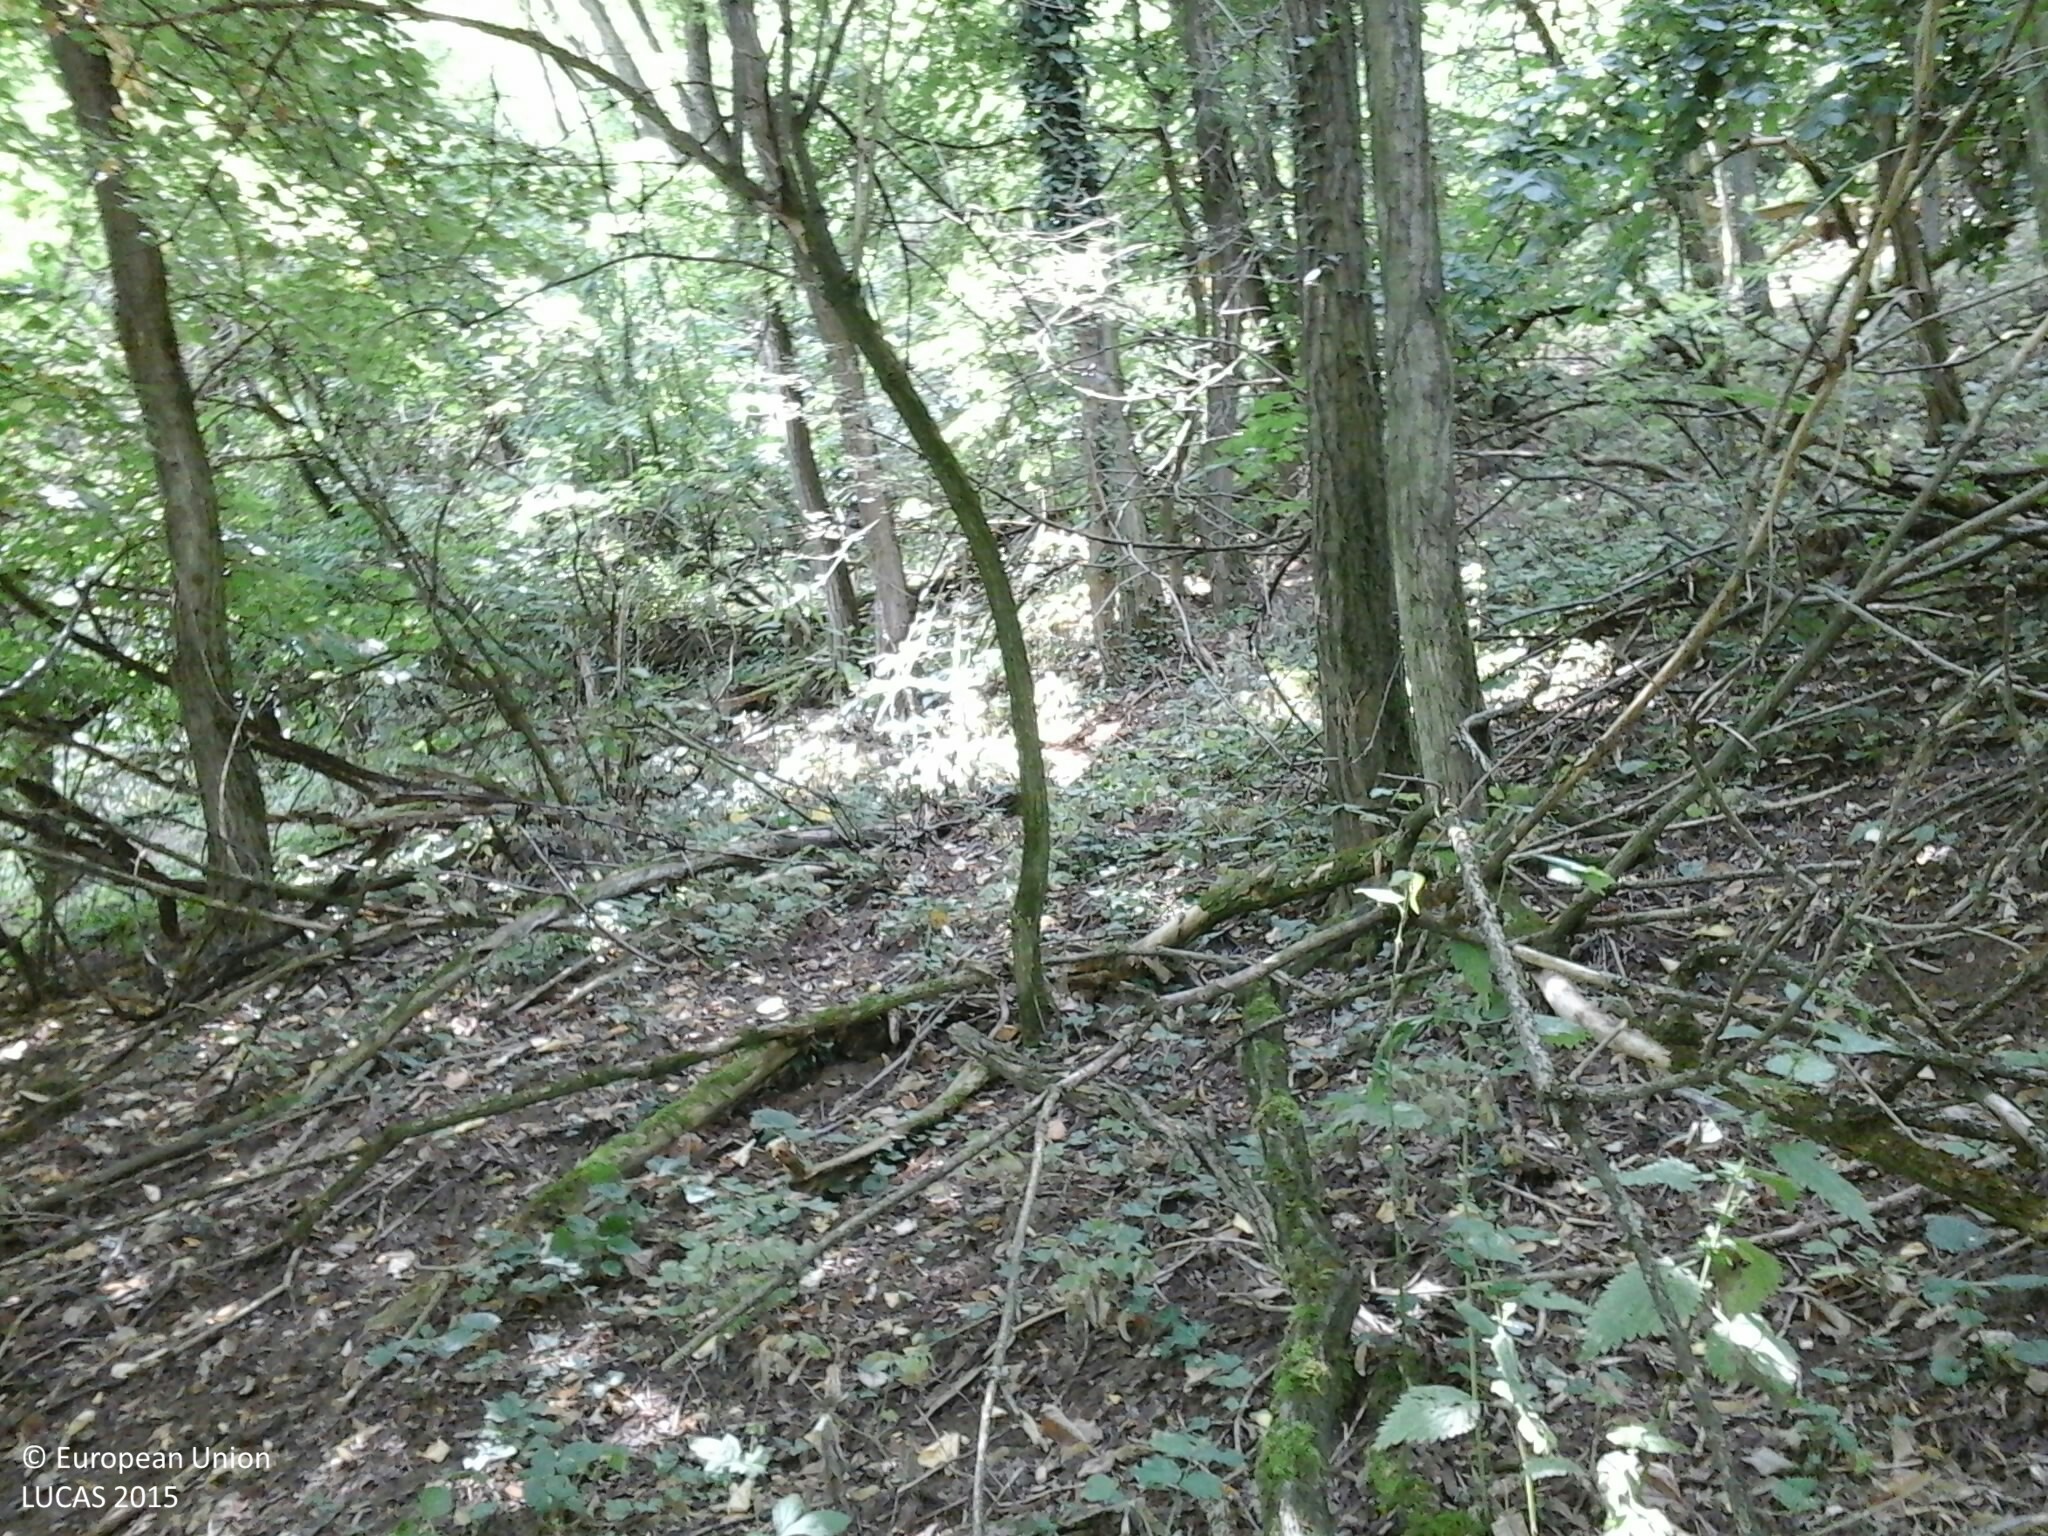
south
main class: Woodland
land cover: Broadleaved woodland
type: mesophytic deciduous forest
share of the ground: > 75 %
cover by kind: broadleaved forest trees 100 %
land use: Forestry
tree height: > 5 m
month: August
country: HU
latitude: 46.7326
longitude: 18.0828
